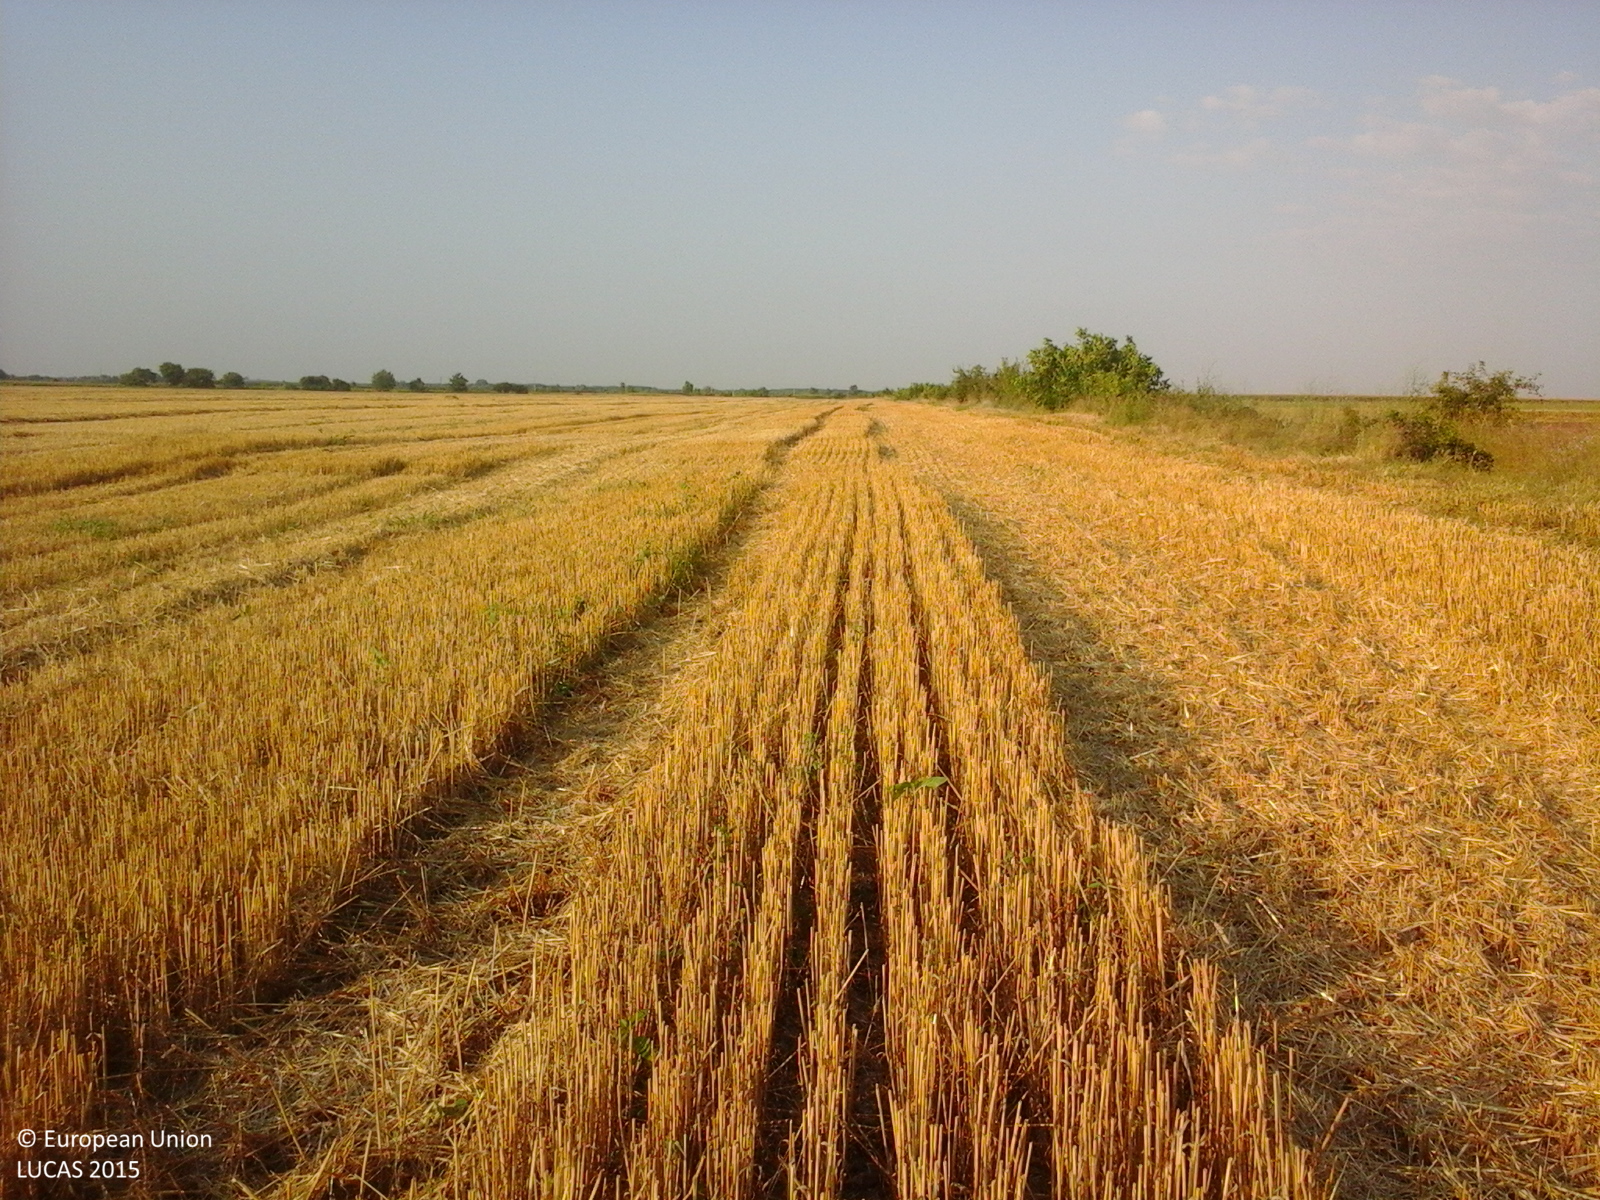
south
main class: Cropland
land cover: Durum wheat
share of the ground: 25 - 50 %
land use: Agriculture (excluding fallow land and kitchen gardens)
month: July
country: RO
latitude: 44.5888
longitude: 27.1254
